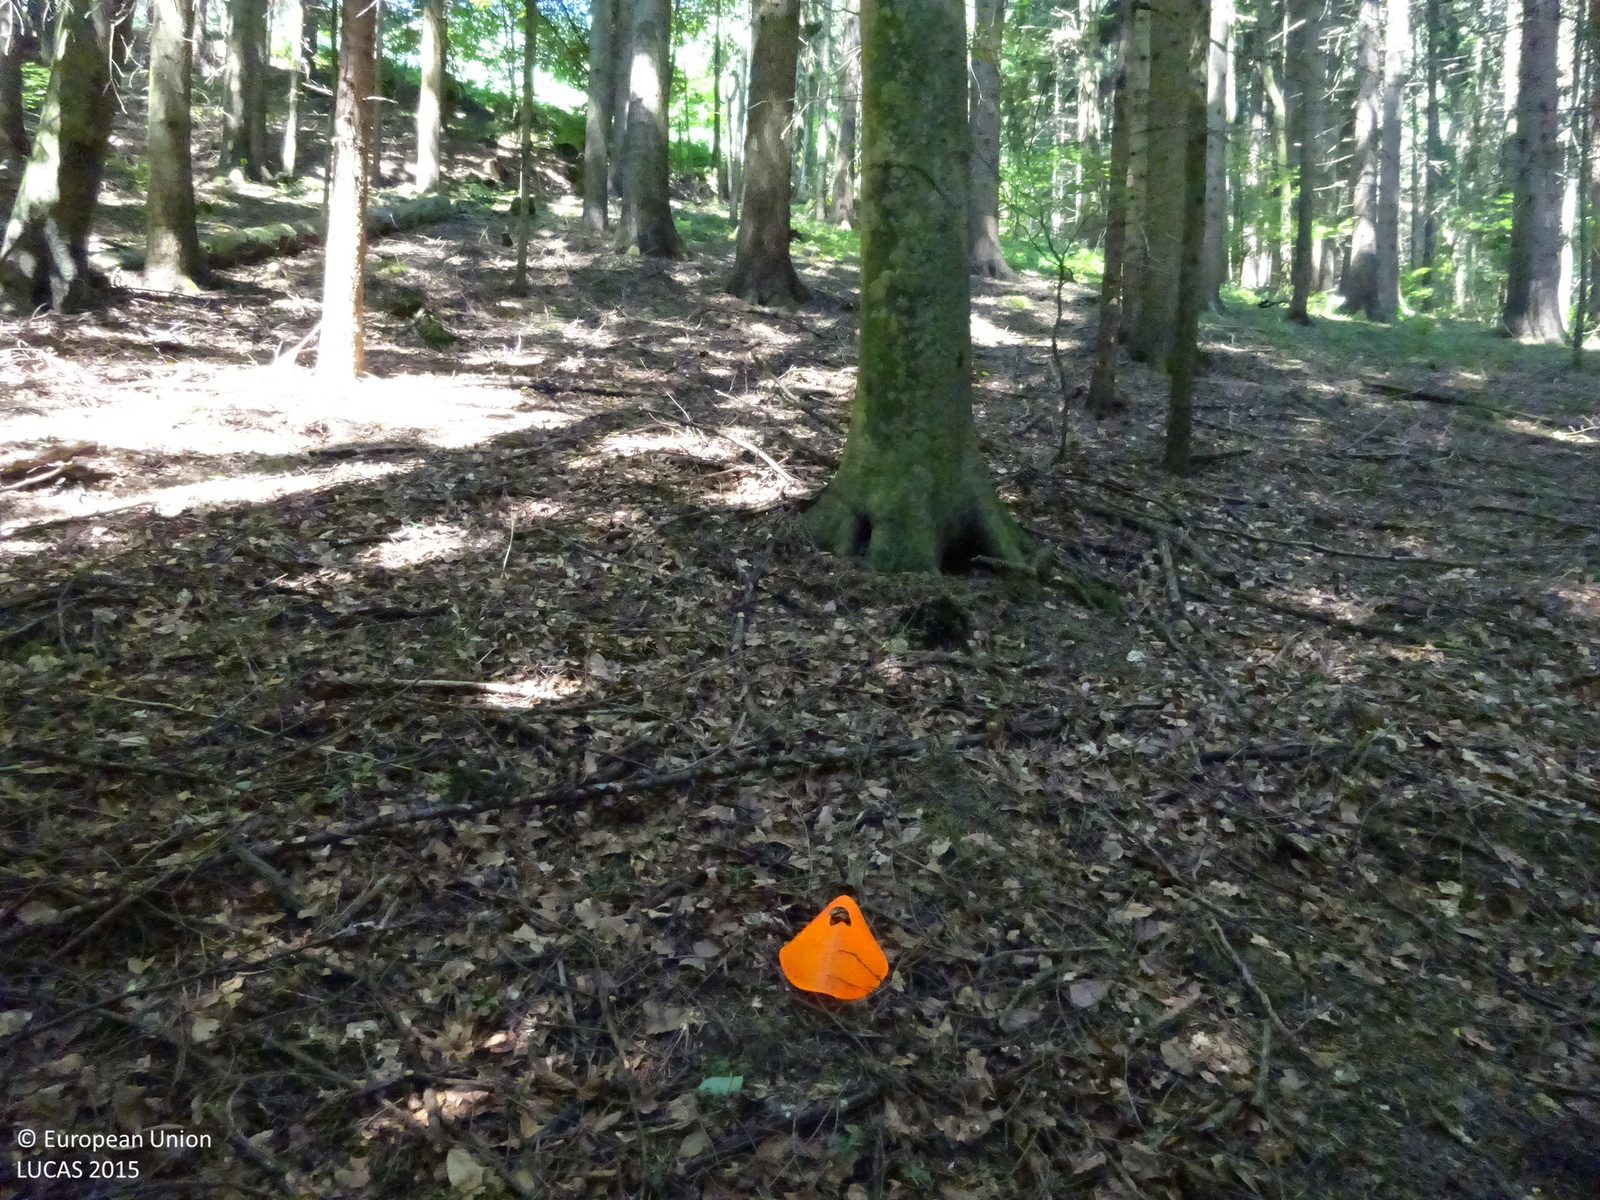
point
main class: Woodland
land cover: Spruce dominated mixed woodland
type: mountainous beech forest
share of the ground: > 75 %
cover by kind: coniferous forest trees 75 %, broadleaved forest trees 25 %
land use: Forestry
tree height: > 5 m
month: July
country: AT
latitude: 47.2664
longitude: 15.3000
